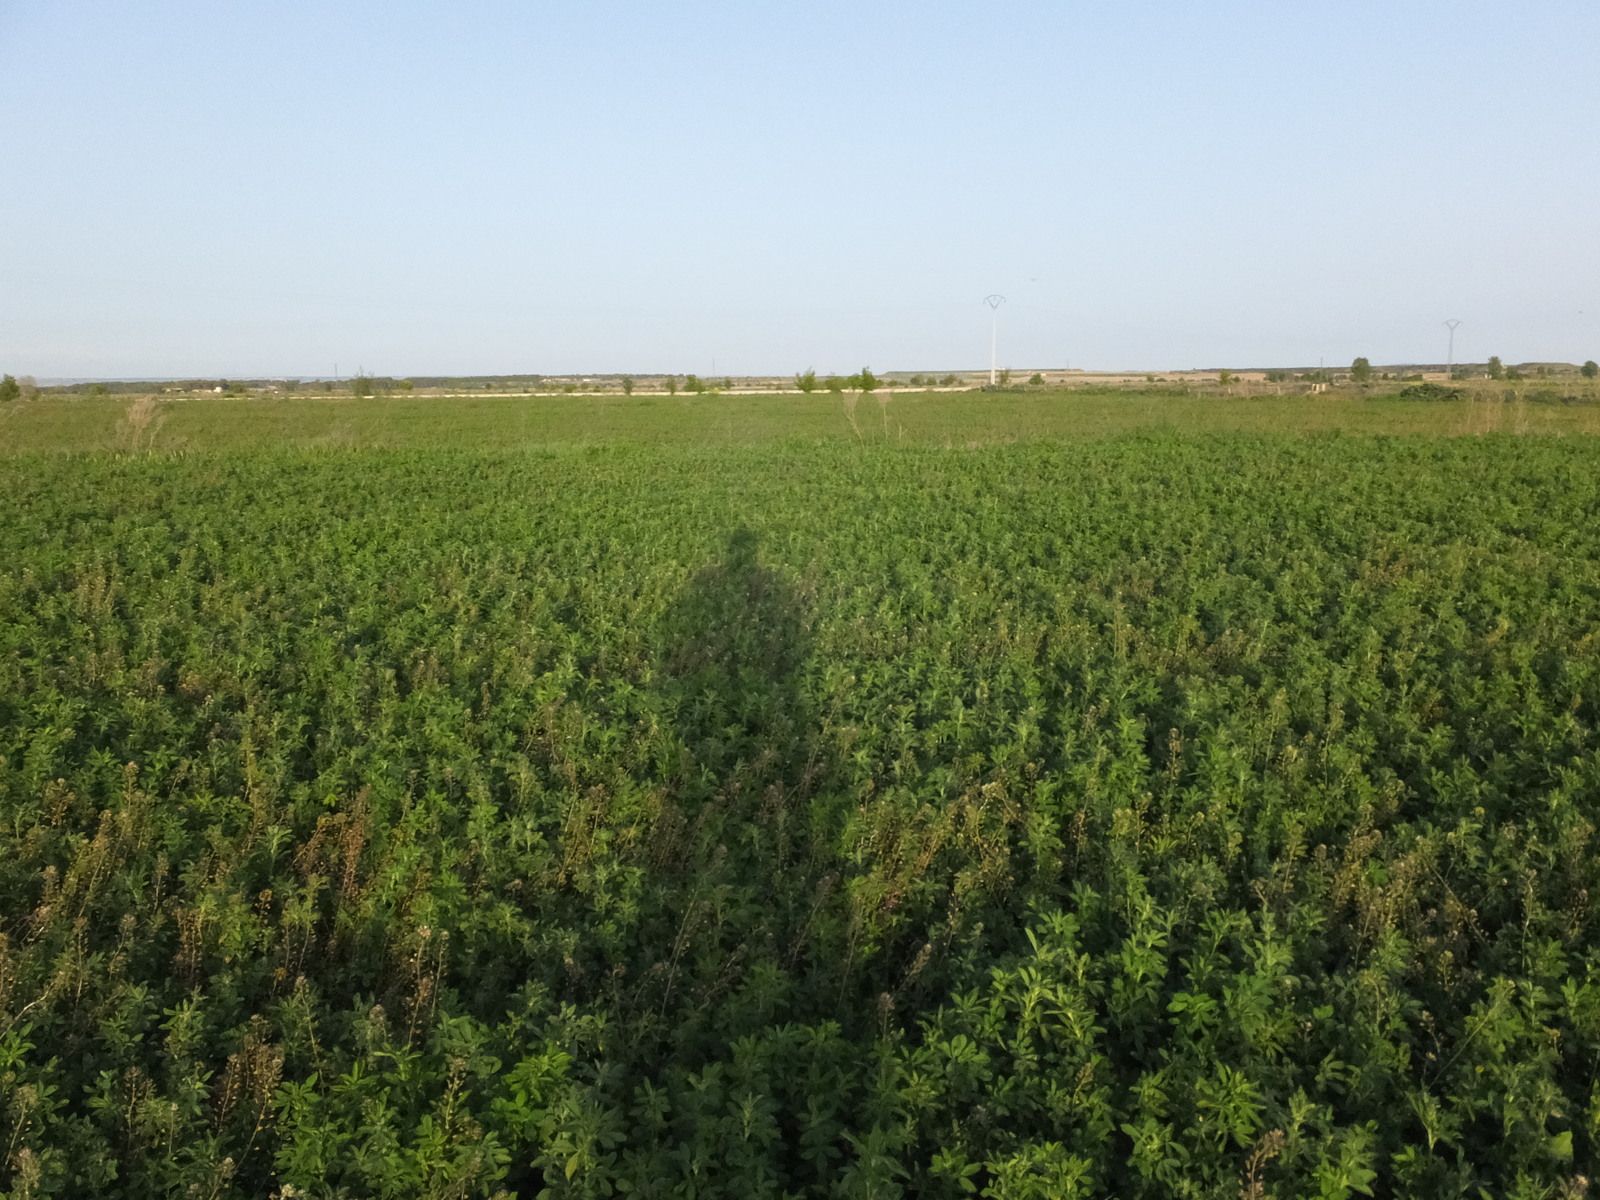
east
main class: Cropland
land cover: Lucerne
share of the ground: > 75 %
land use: Agriculture (excluding fallow land and kitchen gardens)
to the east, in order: Lucerne; Grass margins; Lucerne; Grass margins; Lucerne; Grass margins; Lucerne; Electric lines; Grass margins; Ditches and canals; Grass margins; Lucerne; Grass margins; Lucerne; Grass margins; Lucerne
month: April
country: ES
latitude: 41.7966
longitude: -0.3328
